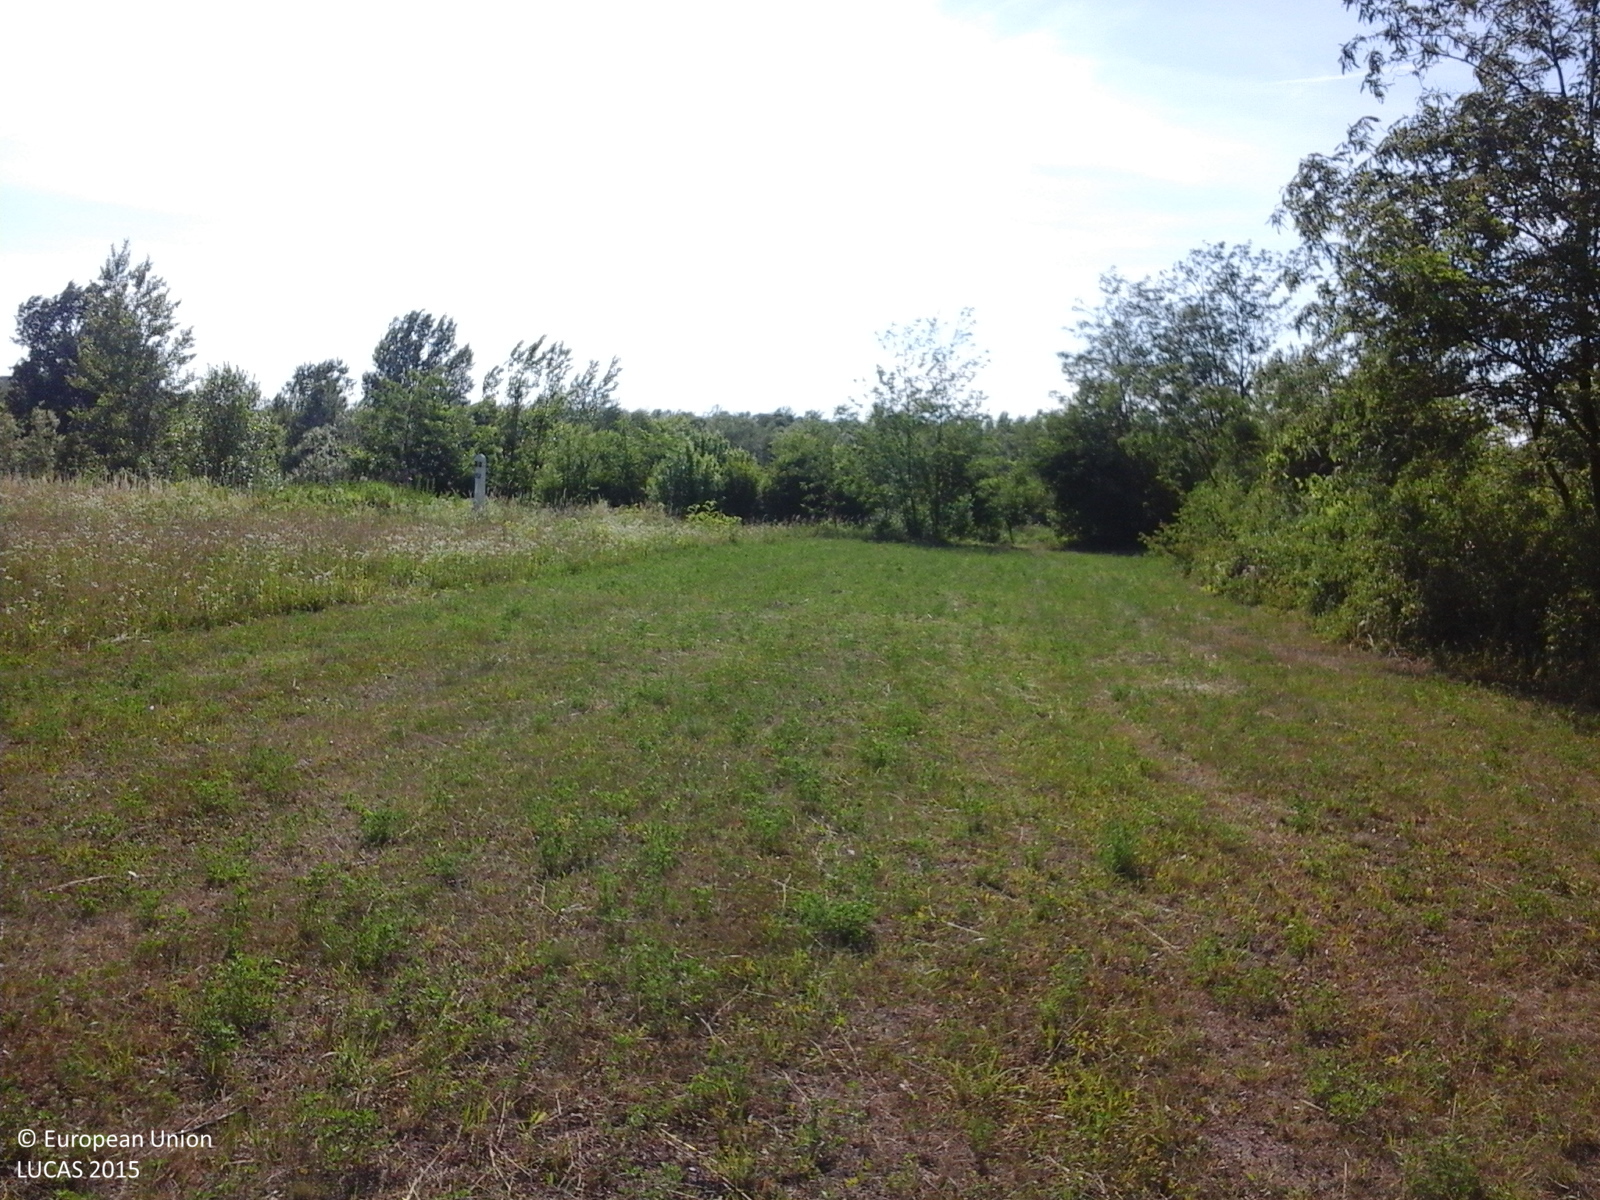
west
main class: Cropland
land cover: Other leguminous and mixtures for fodder
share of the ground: 25 - 50 %
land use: Agriculture (excluding fallow land and kitchen gardens)
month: June
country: RO
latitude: 48.2471
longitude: 26.7871
